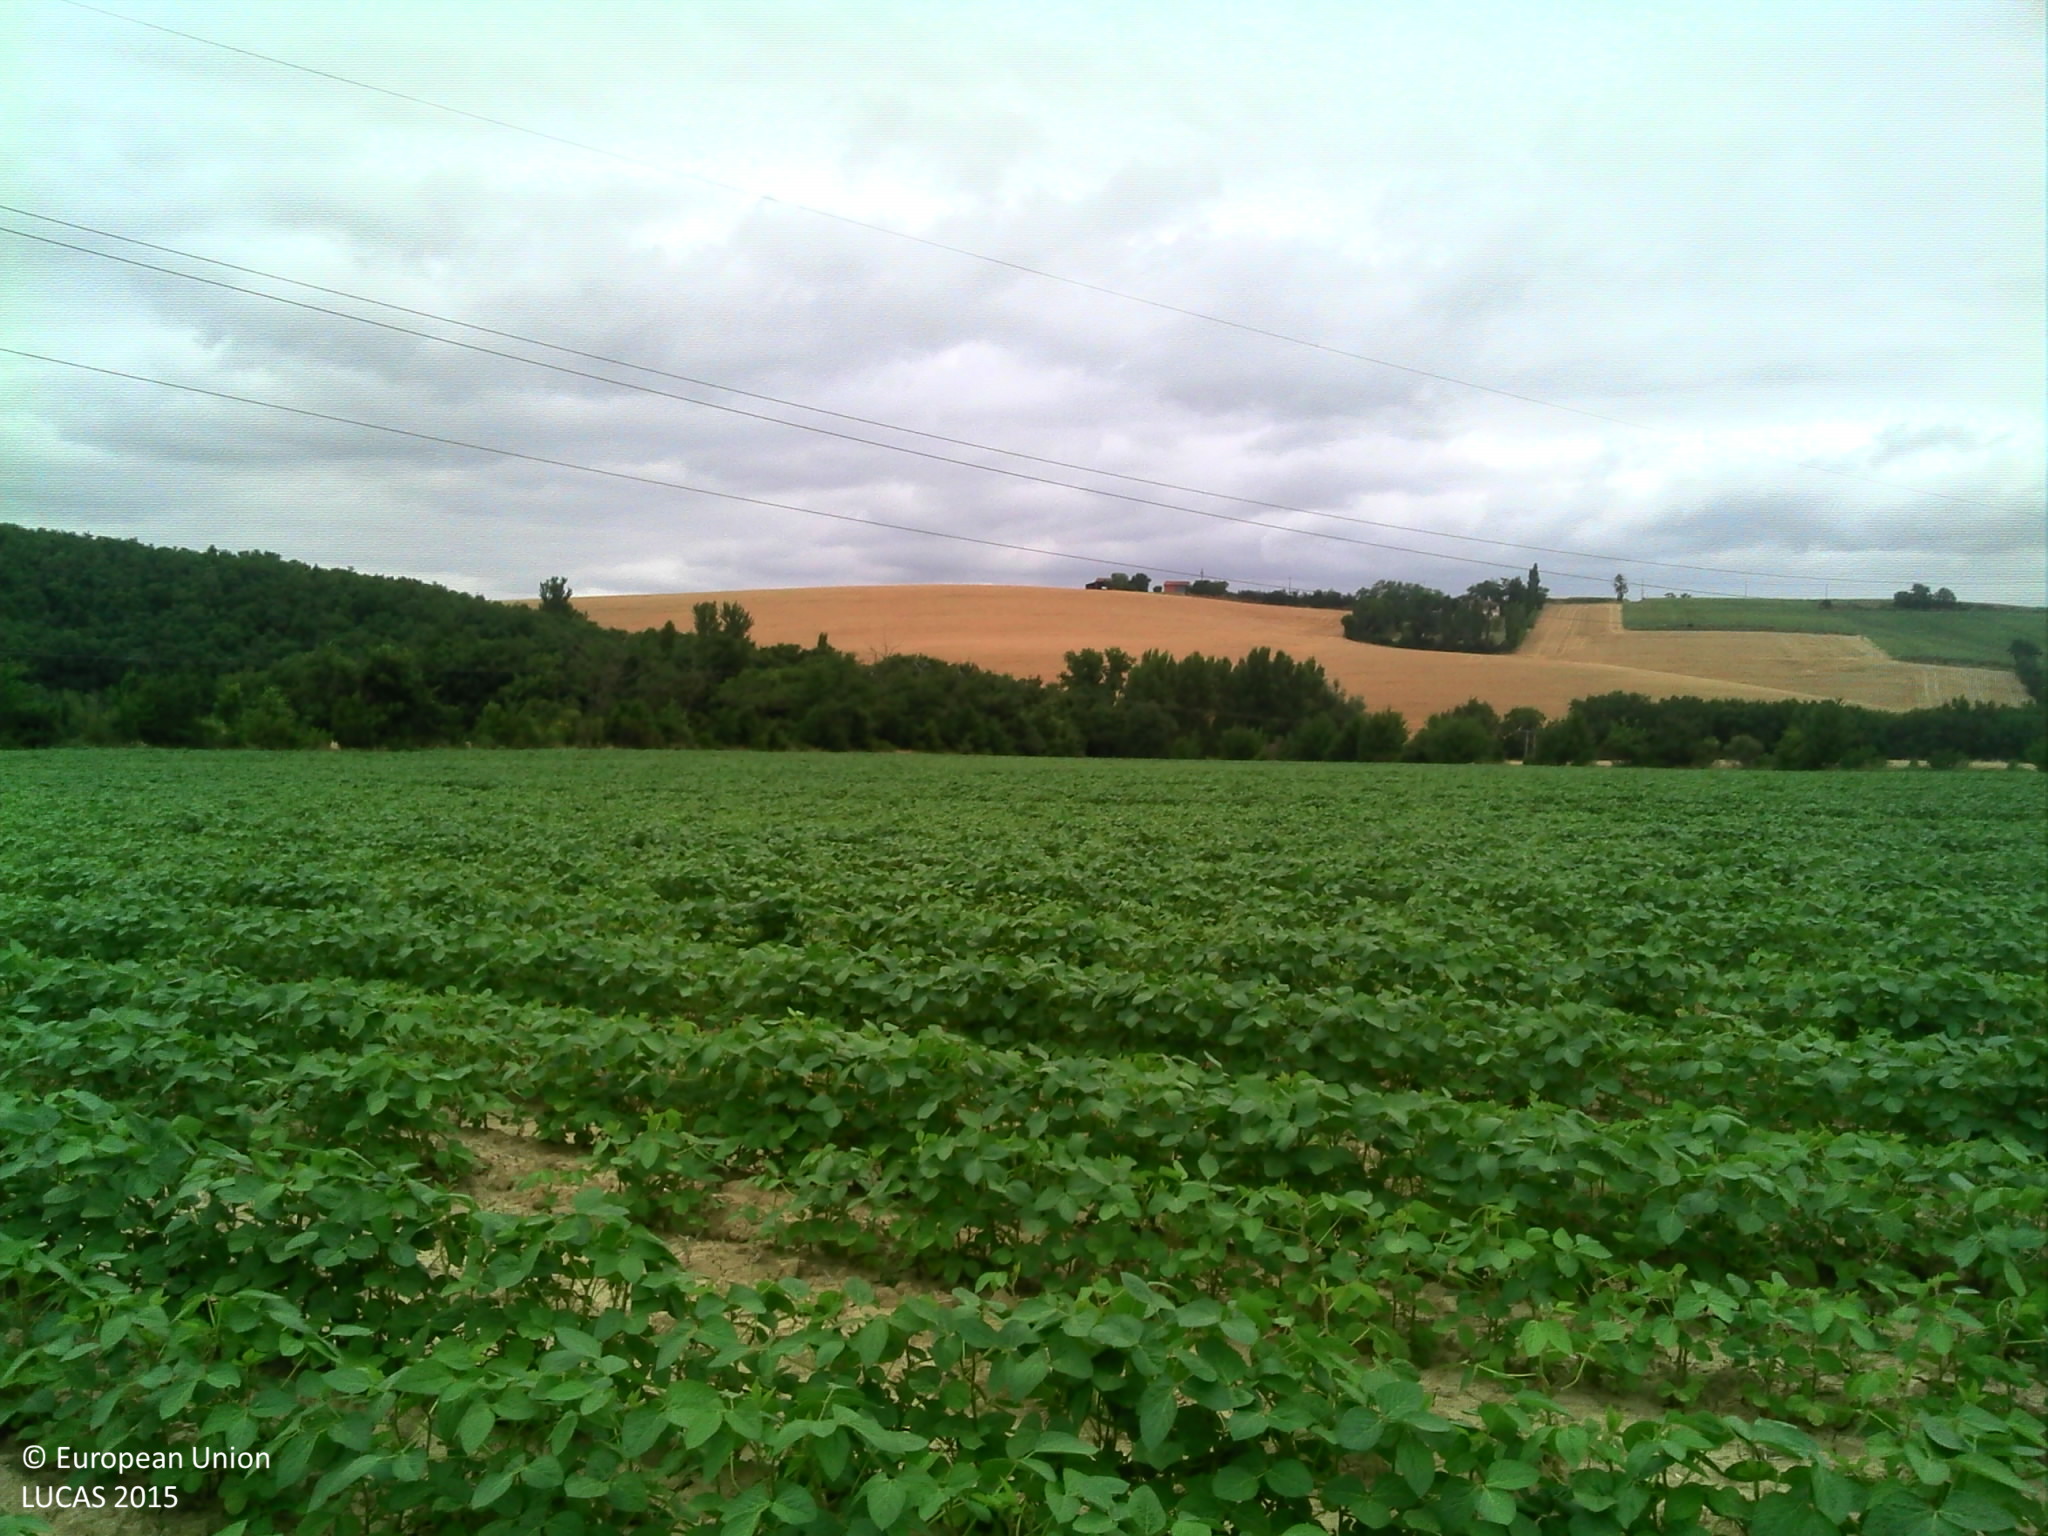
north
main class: Cropland
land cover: Soya
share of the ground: > 75 %
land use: Agriculture (excluding fallow land and kitchen gardens)
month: July
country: FR
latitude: 43.4845
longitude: 1.6086
